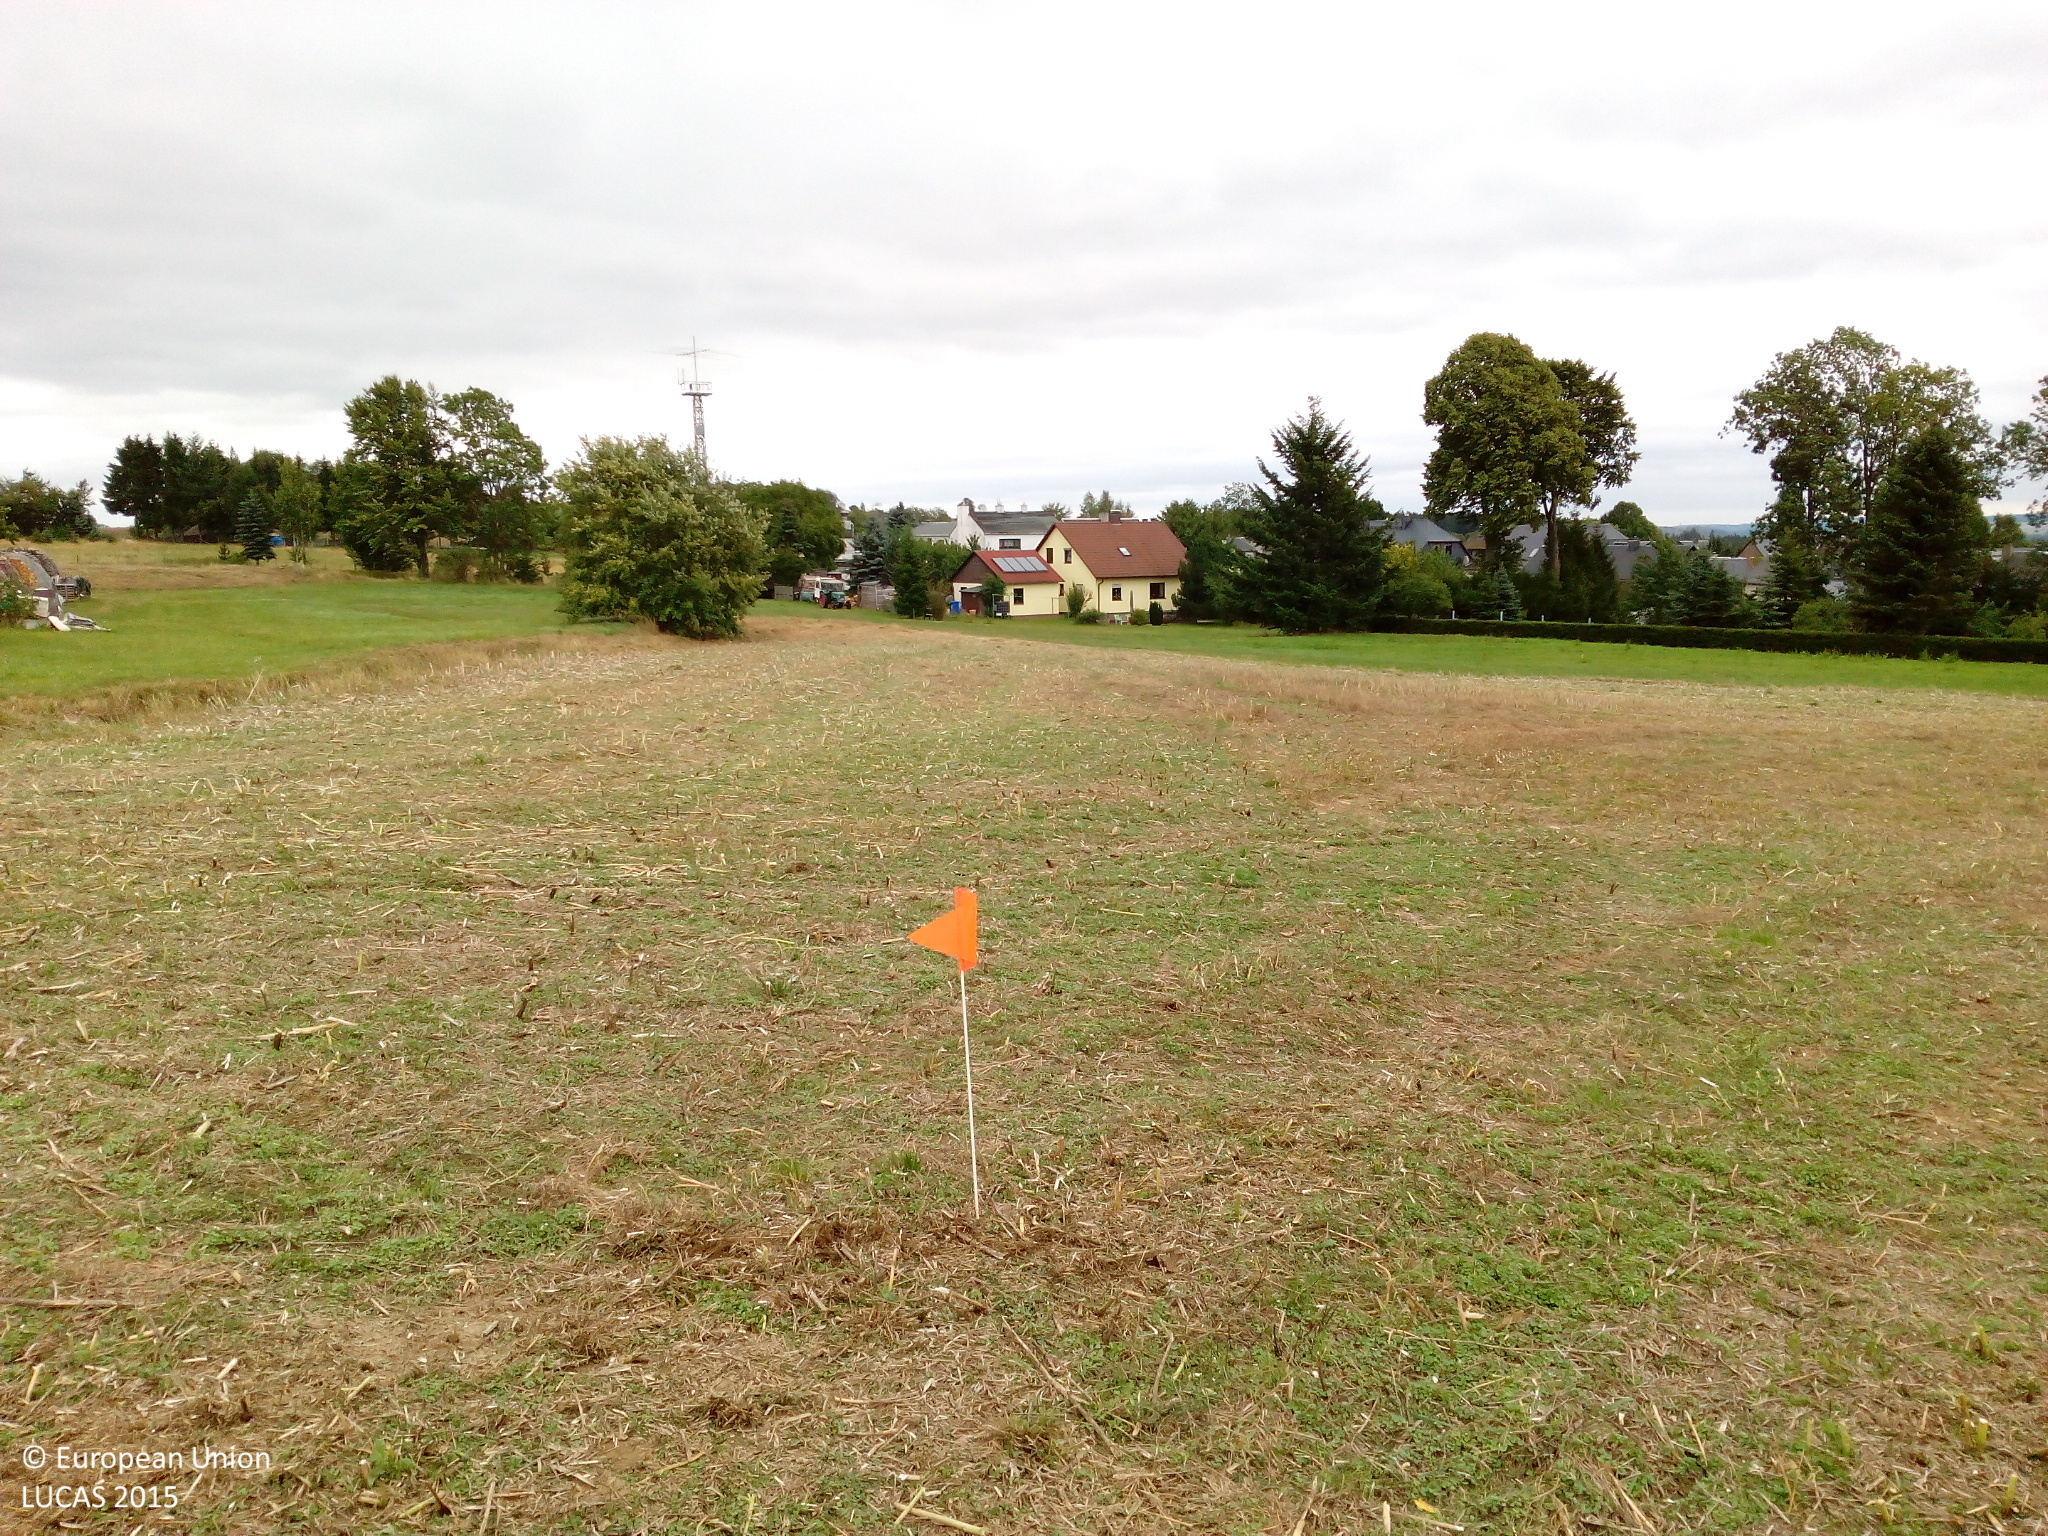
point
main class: Cropland
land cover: Rape and turnip rape
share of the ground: < 10 %
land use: Agriculture (excluding fallow land and kitchen gardens)
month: August
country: DE
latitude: 50.4066
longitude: 11.6177
